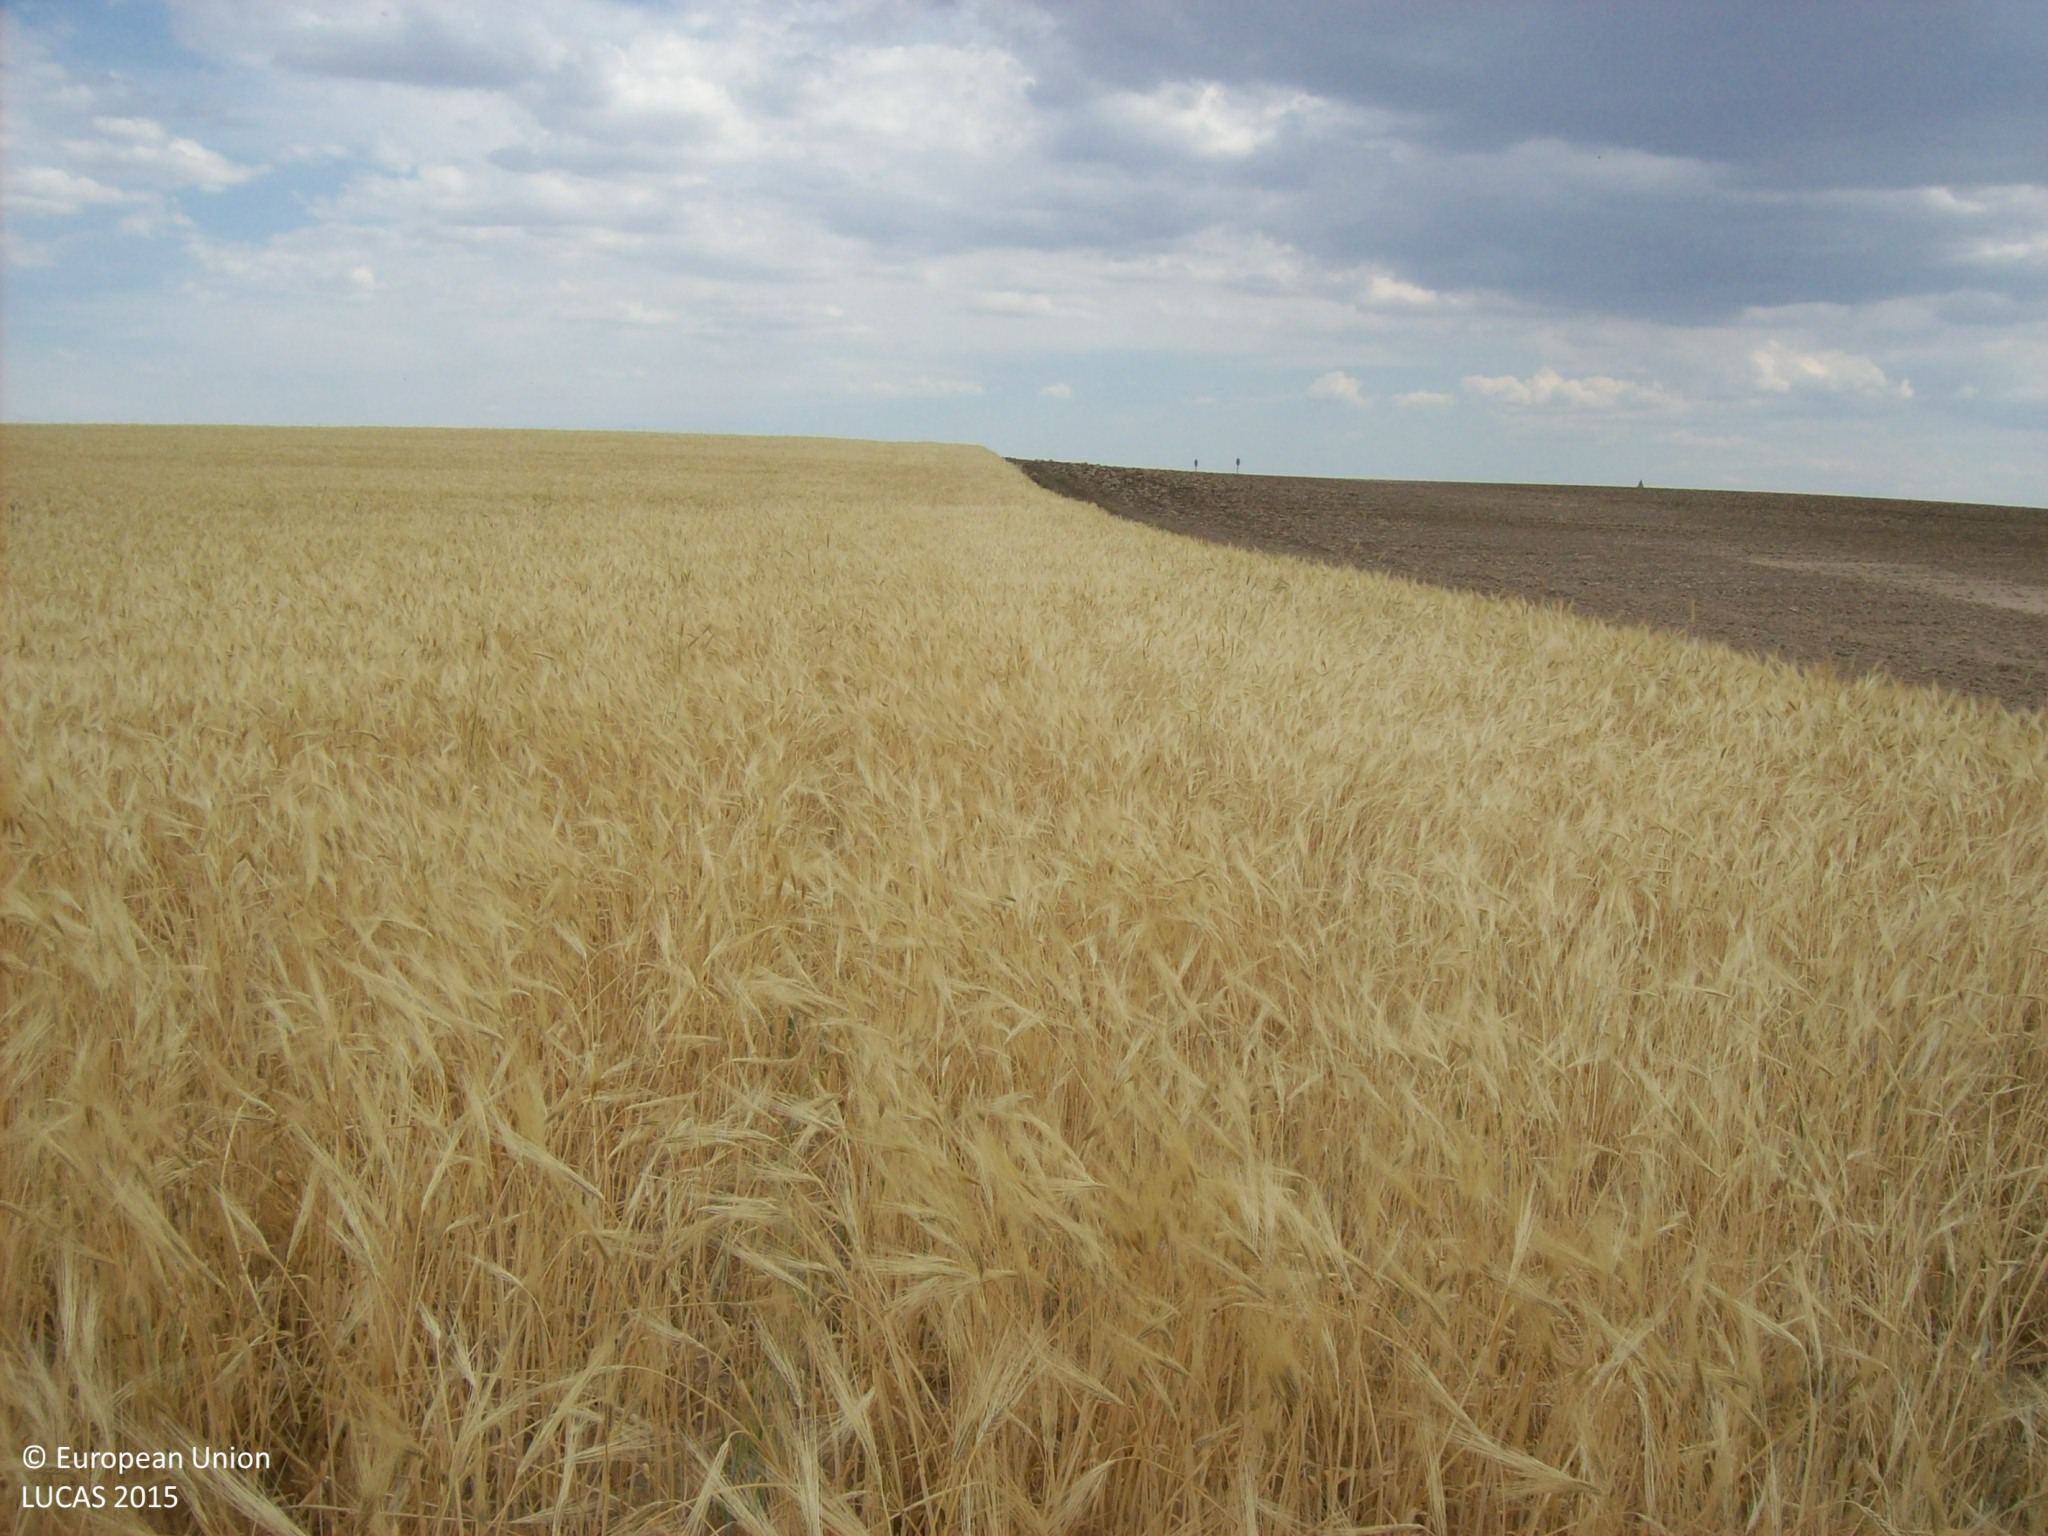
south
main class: Cropland
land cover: Barley
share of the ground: > 75 %
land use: Agriculture (excluding fallow land and kitchen gardens)
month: June
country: ES
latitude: 41.0849
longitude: -5.0301
